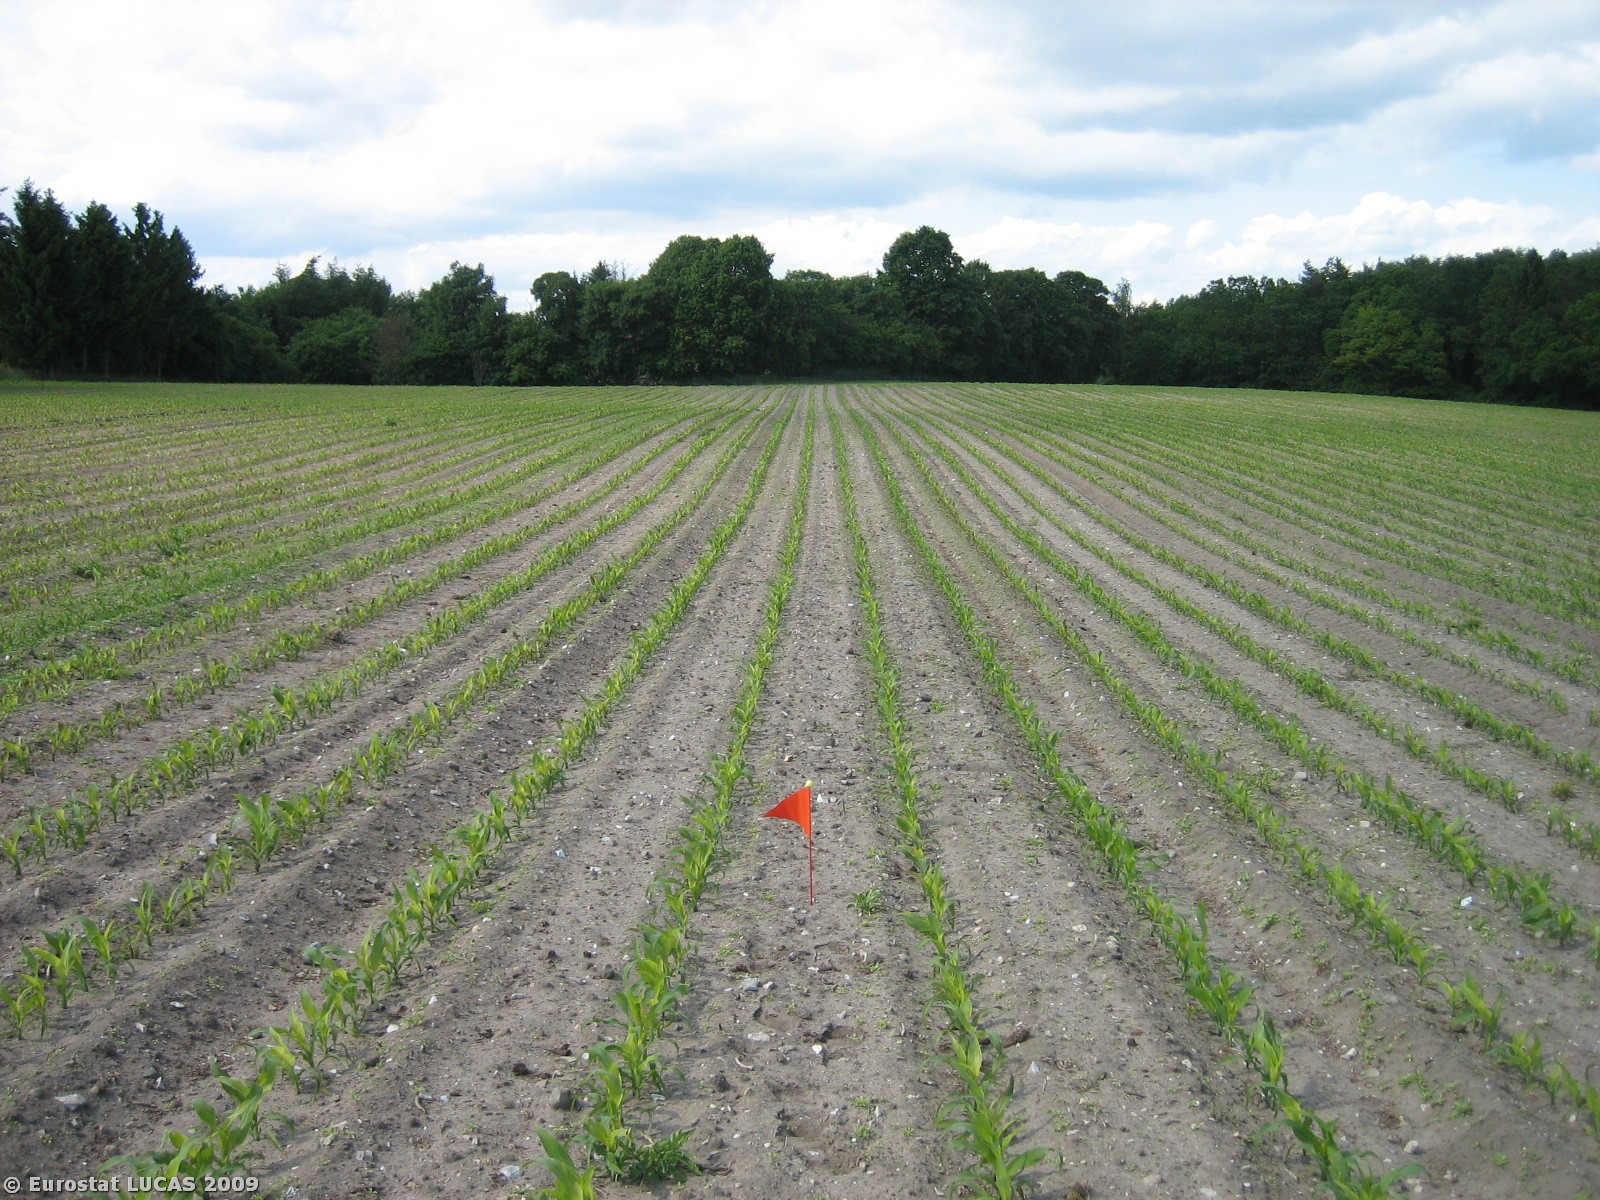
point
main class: Cropland
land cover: Maize
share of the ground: < 10 %
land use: Agriculture (excluding fallow land and kitchen gardens)
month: June
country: DK
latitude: 56.0079
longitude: 9.8558
